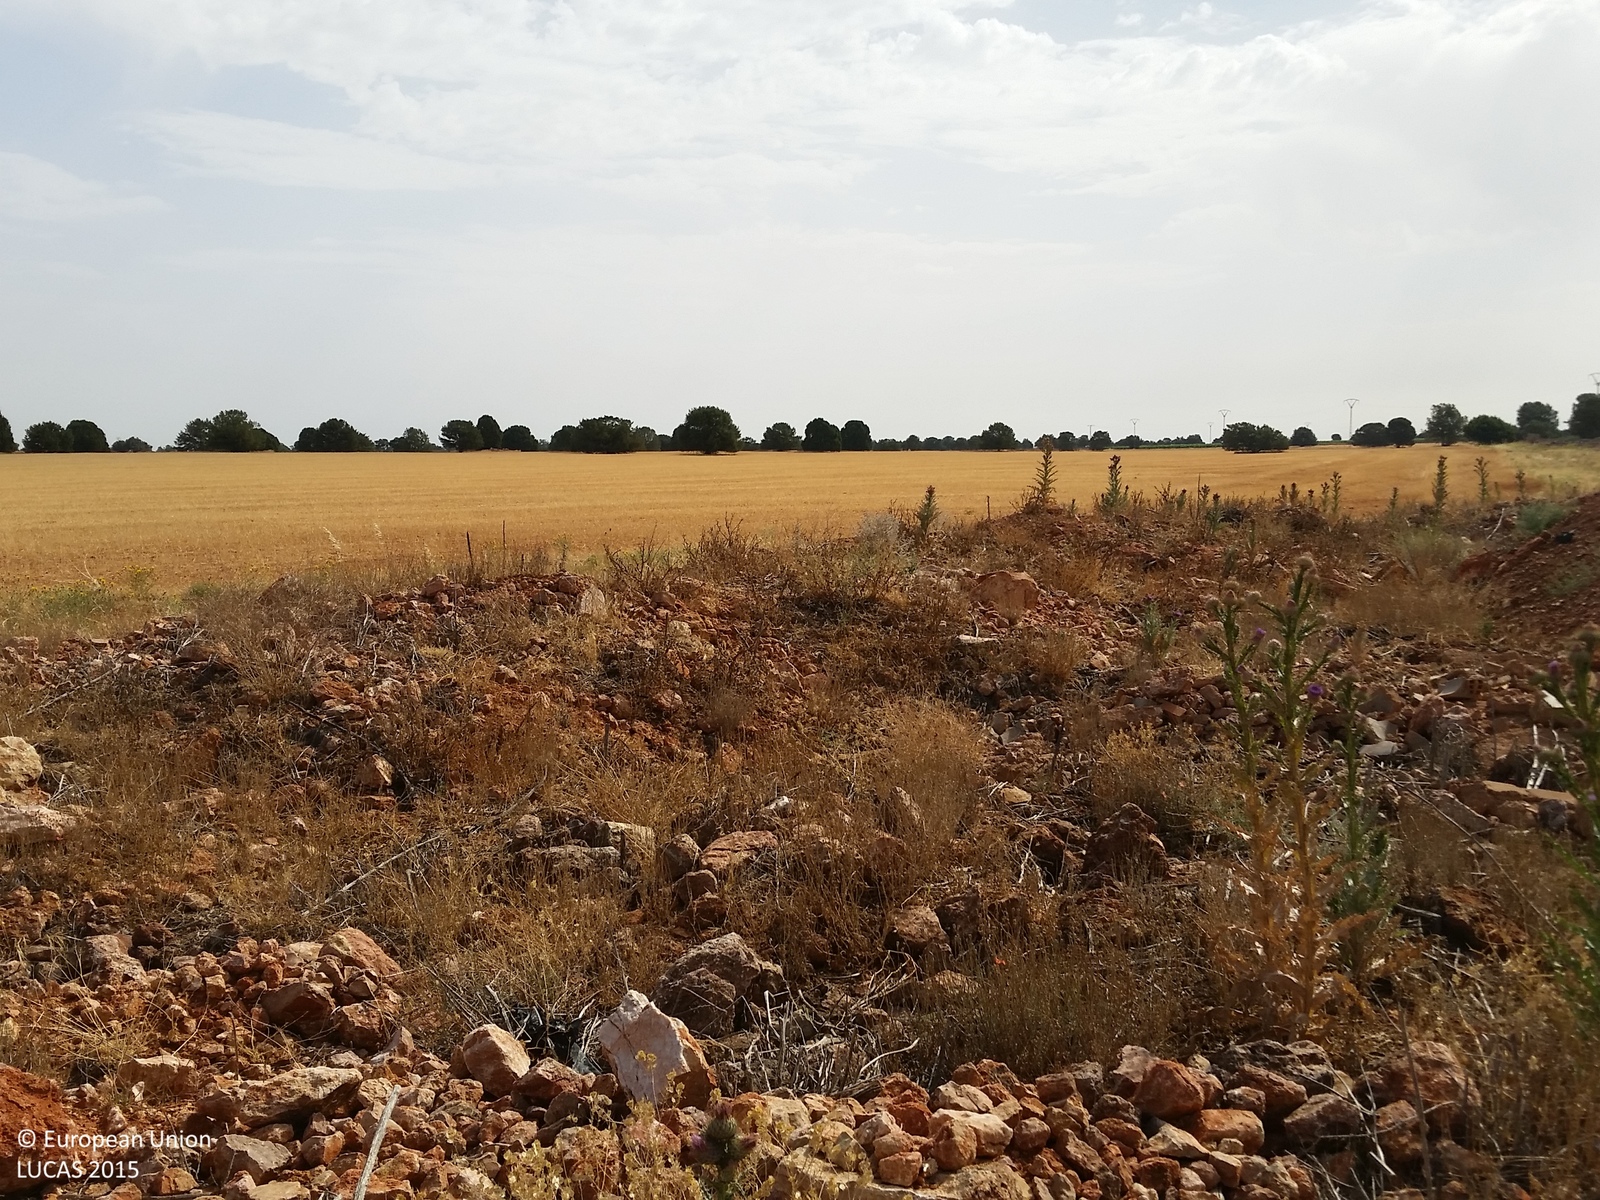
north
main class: Grassland
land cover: Grassland without tree/shrub cover
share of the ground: > 75 %
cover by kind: herbaceous plants 90 %, consolidated bare surface 10 %
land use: Semi-natural and natural areas not in use
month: July
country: ES
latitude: 38.8568
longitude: -2.6696
